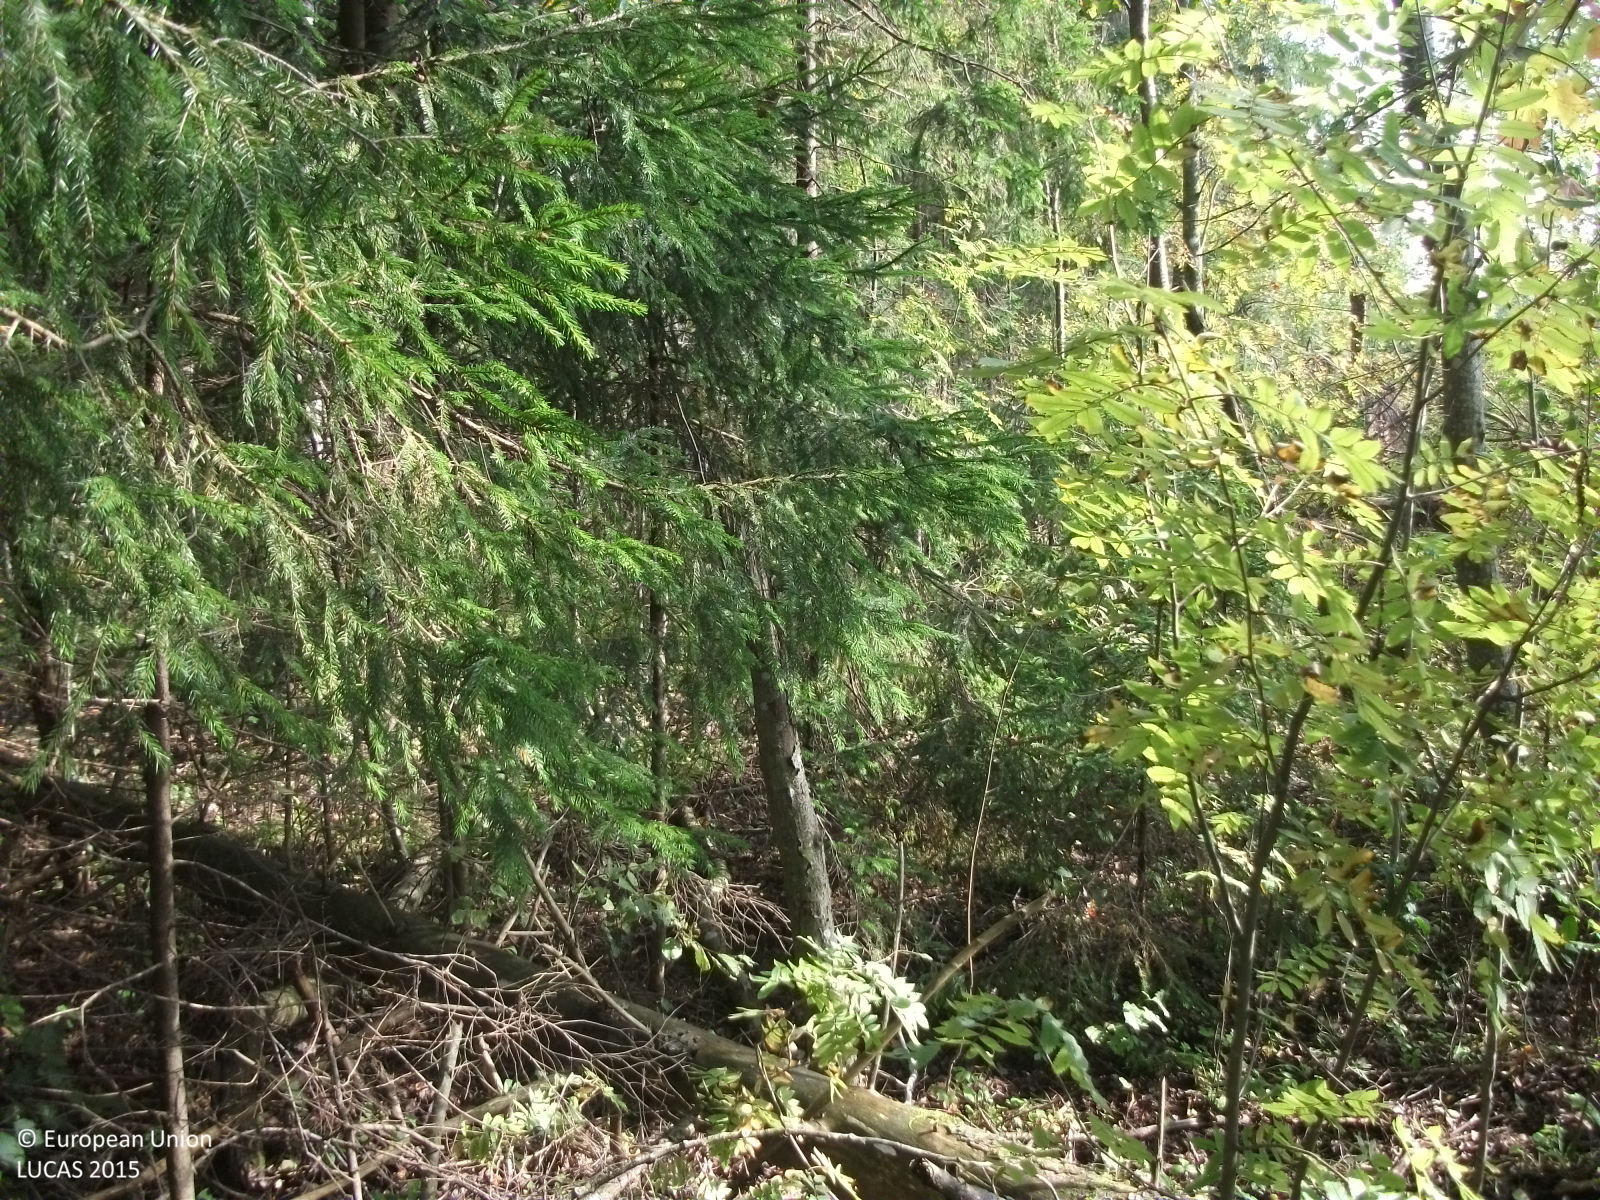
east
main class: Woodland
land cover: Spruce dominated mixed woodland
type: hemiboreal forest and nemoral coniferous forest and mixed broadleaved-coniferous forest
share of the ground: > 75 %
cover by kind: coniferous forest trees 65 %, broadleaved forest trees 25 %, herbaceous plants 5 %
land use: Forestry
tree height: > 5 m
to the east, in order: Spruce dominated mixed woodland; Ditches and canals; Other mixed woodland; Pine dominated coniferous woodland
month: September
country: LV
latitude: 57.8651
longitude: 24.8458
